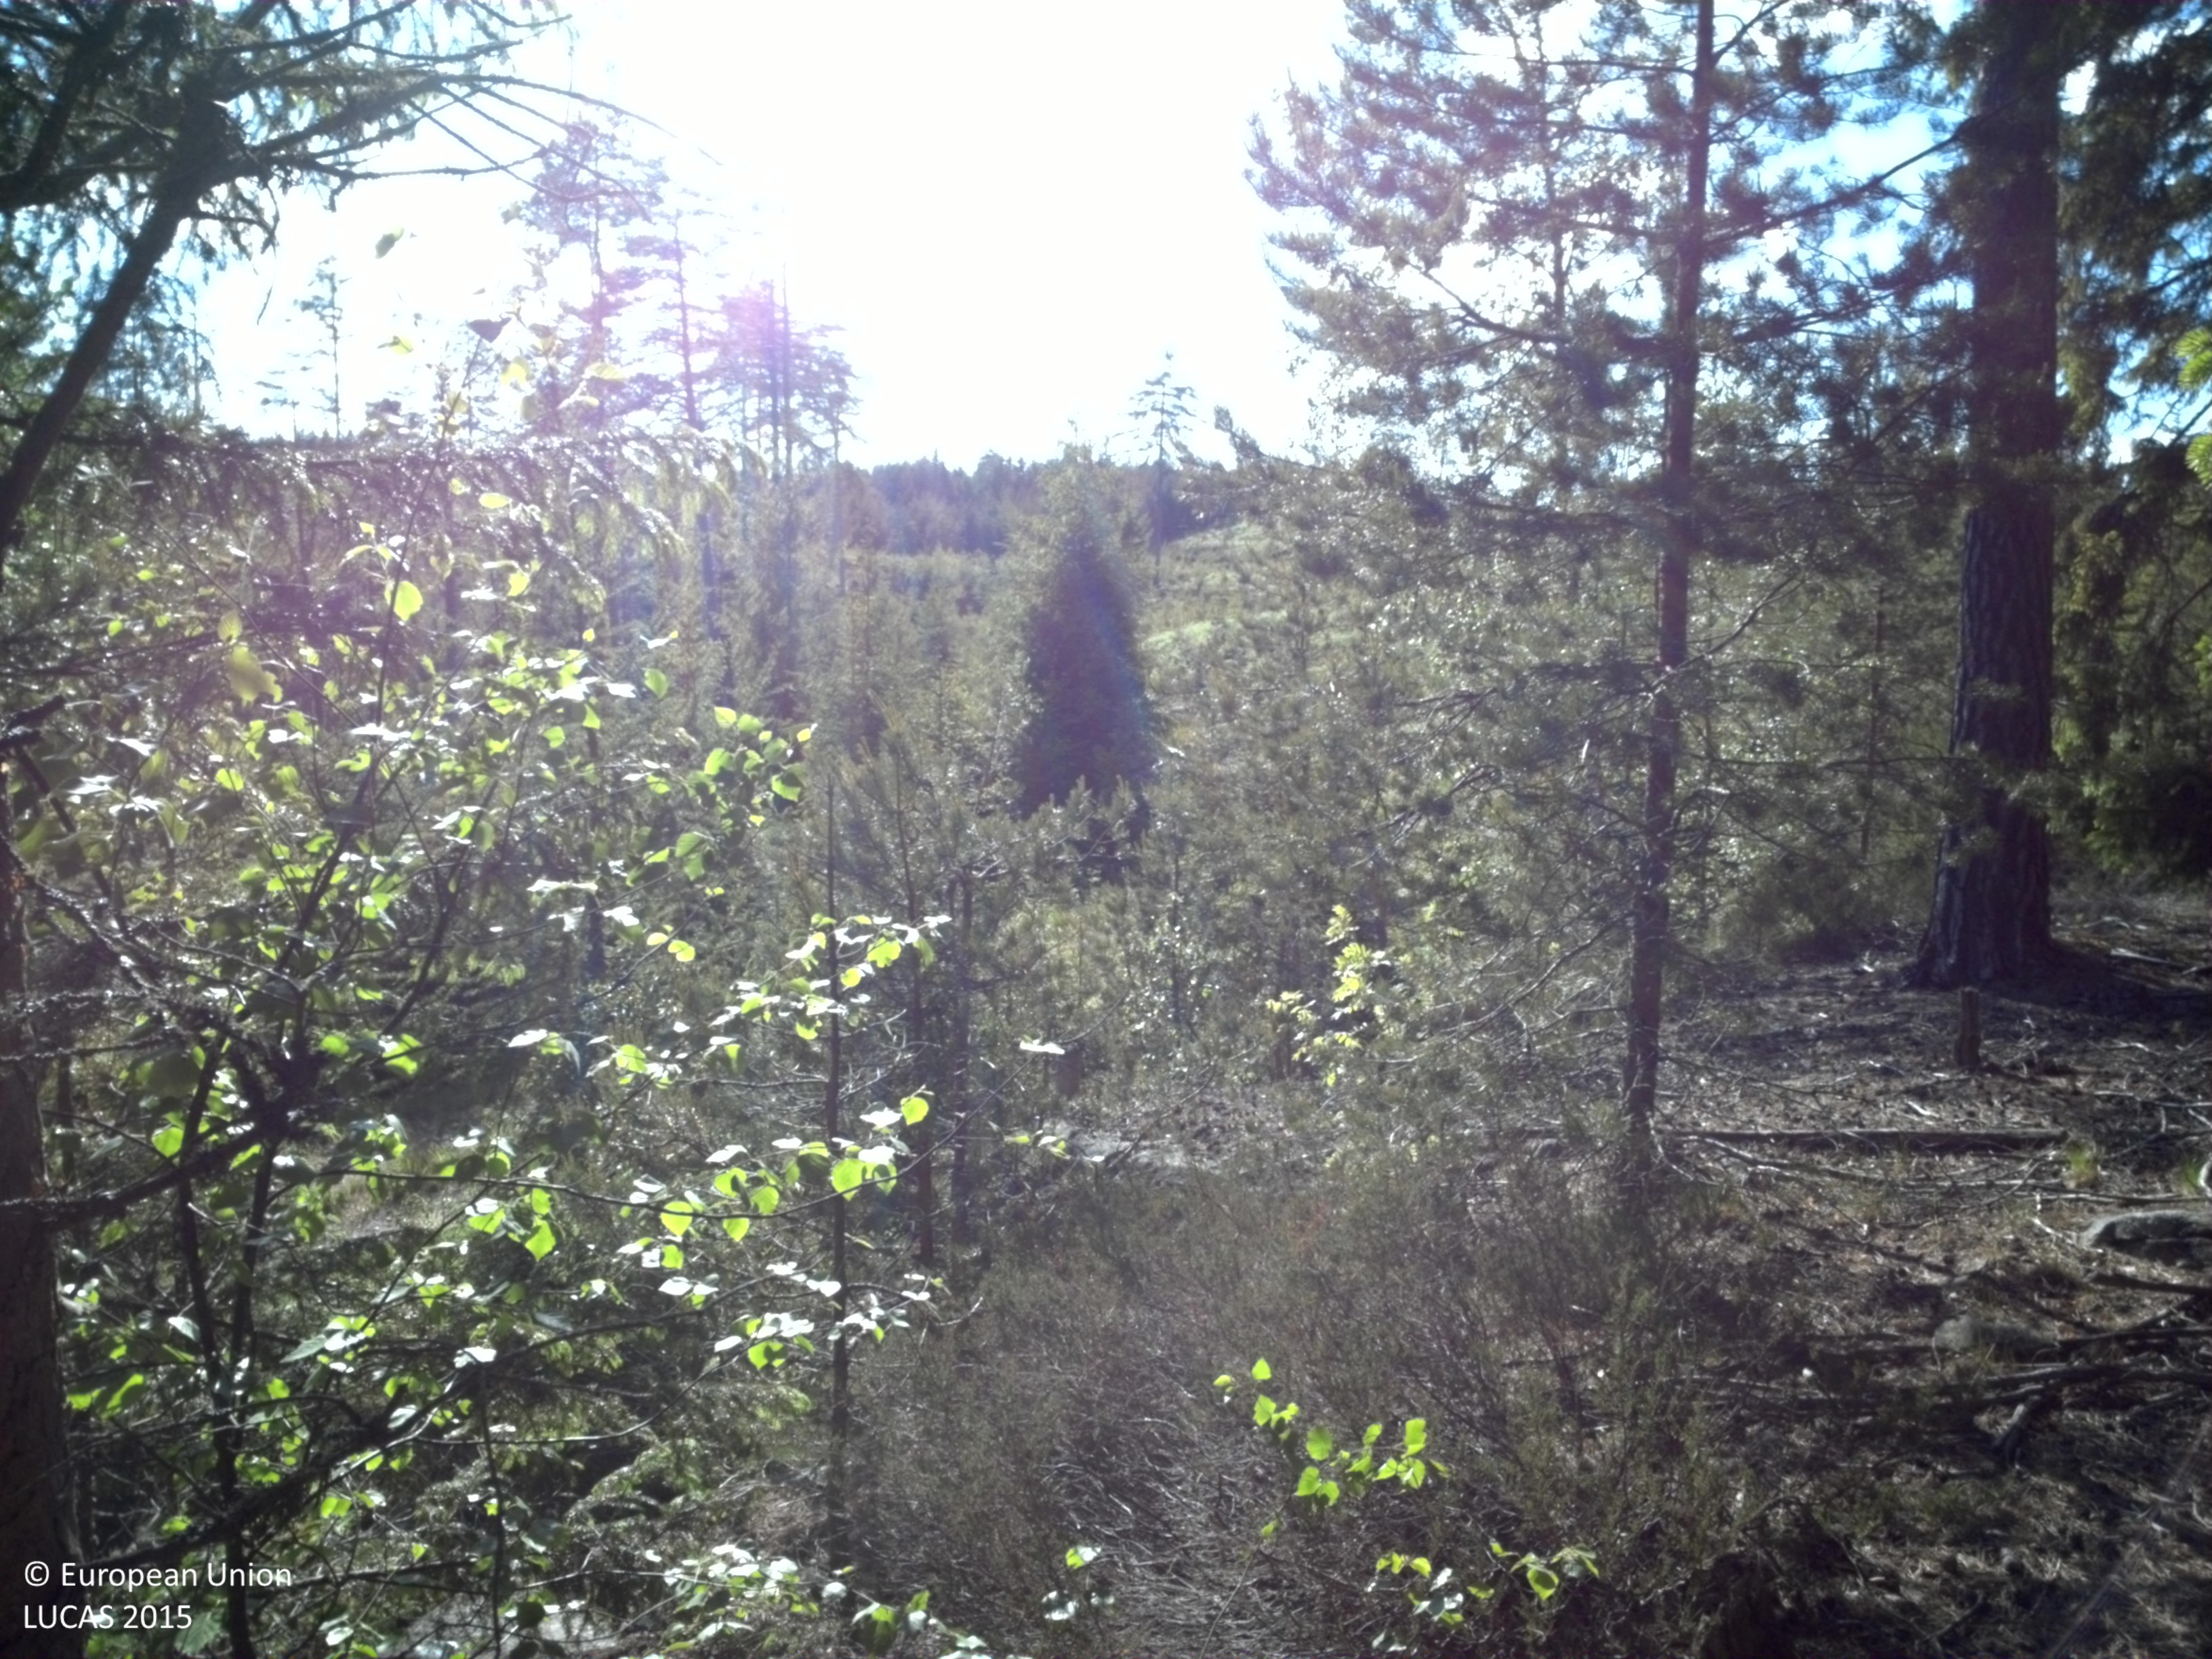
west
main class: Woodland
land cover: Other coniferous woodland
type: boreal forest
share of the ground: > 75 %
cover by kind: coniferous forest trees 80 %, broadleaved forest trees 5 %, shrubs 5 %, herbaceous plants 5 %, lichens and mosses 5 %
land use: Forestry
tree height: > 5 m
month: June
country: SE
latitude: 58.7330
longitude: 14.6742
